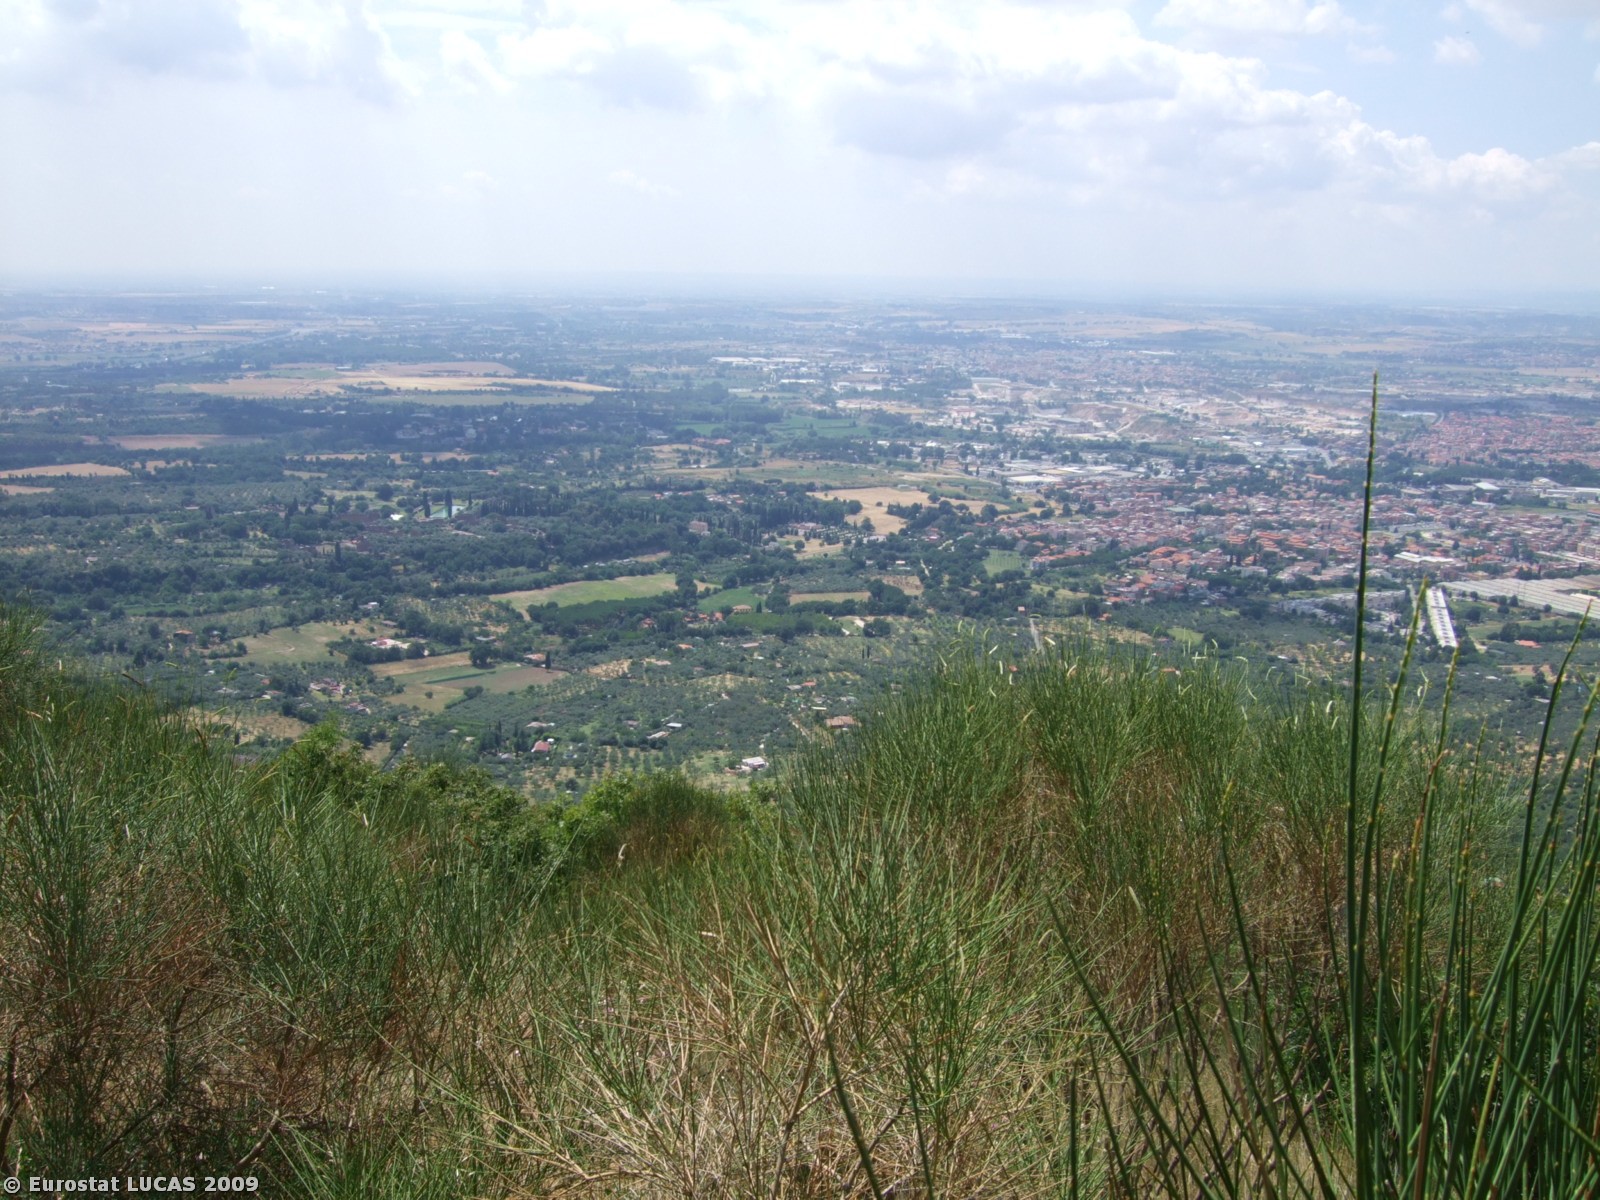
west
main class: Shrubland
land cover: Shrubland with sparse tree cover
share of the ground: 50 - 75 %
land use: Fallow land
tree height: > 5 m
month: June
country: IT
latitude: 41.9465
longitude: 12.8004
